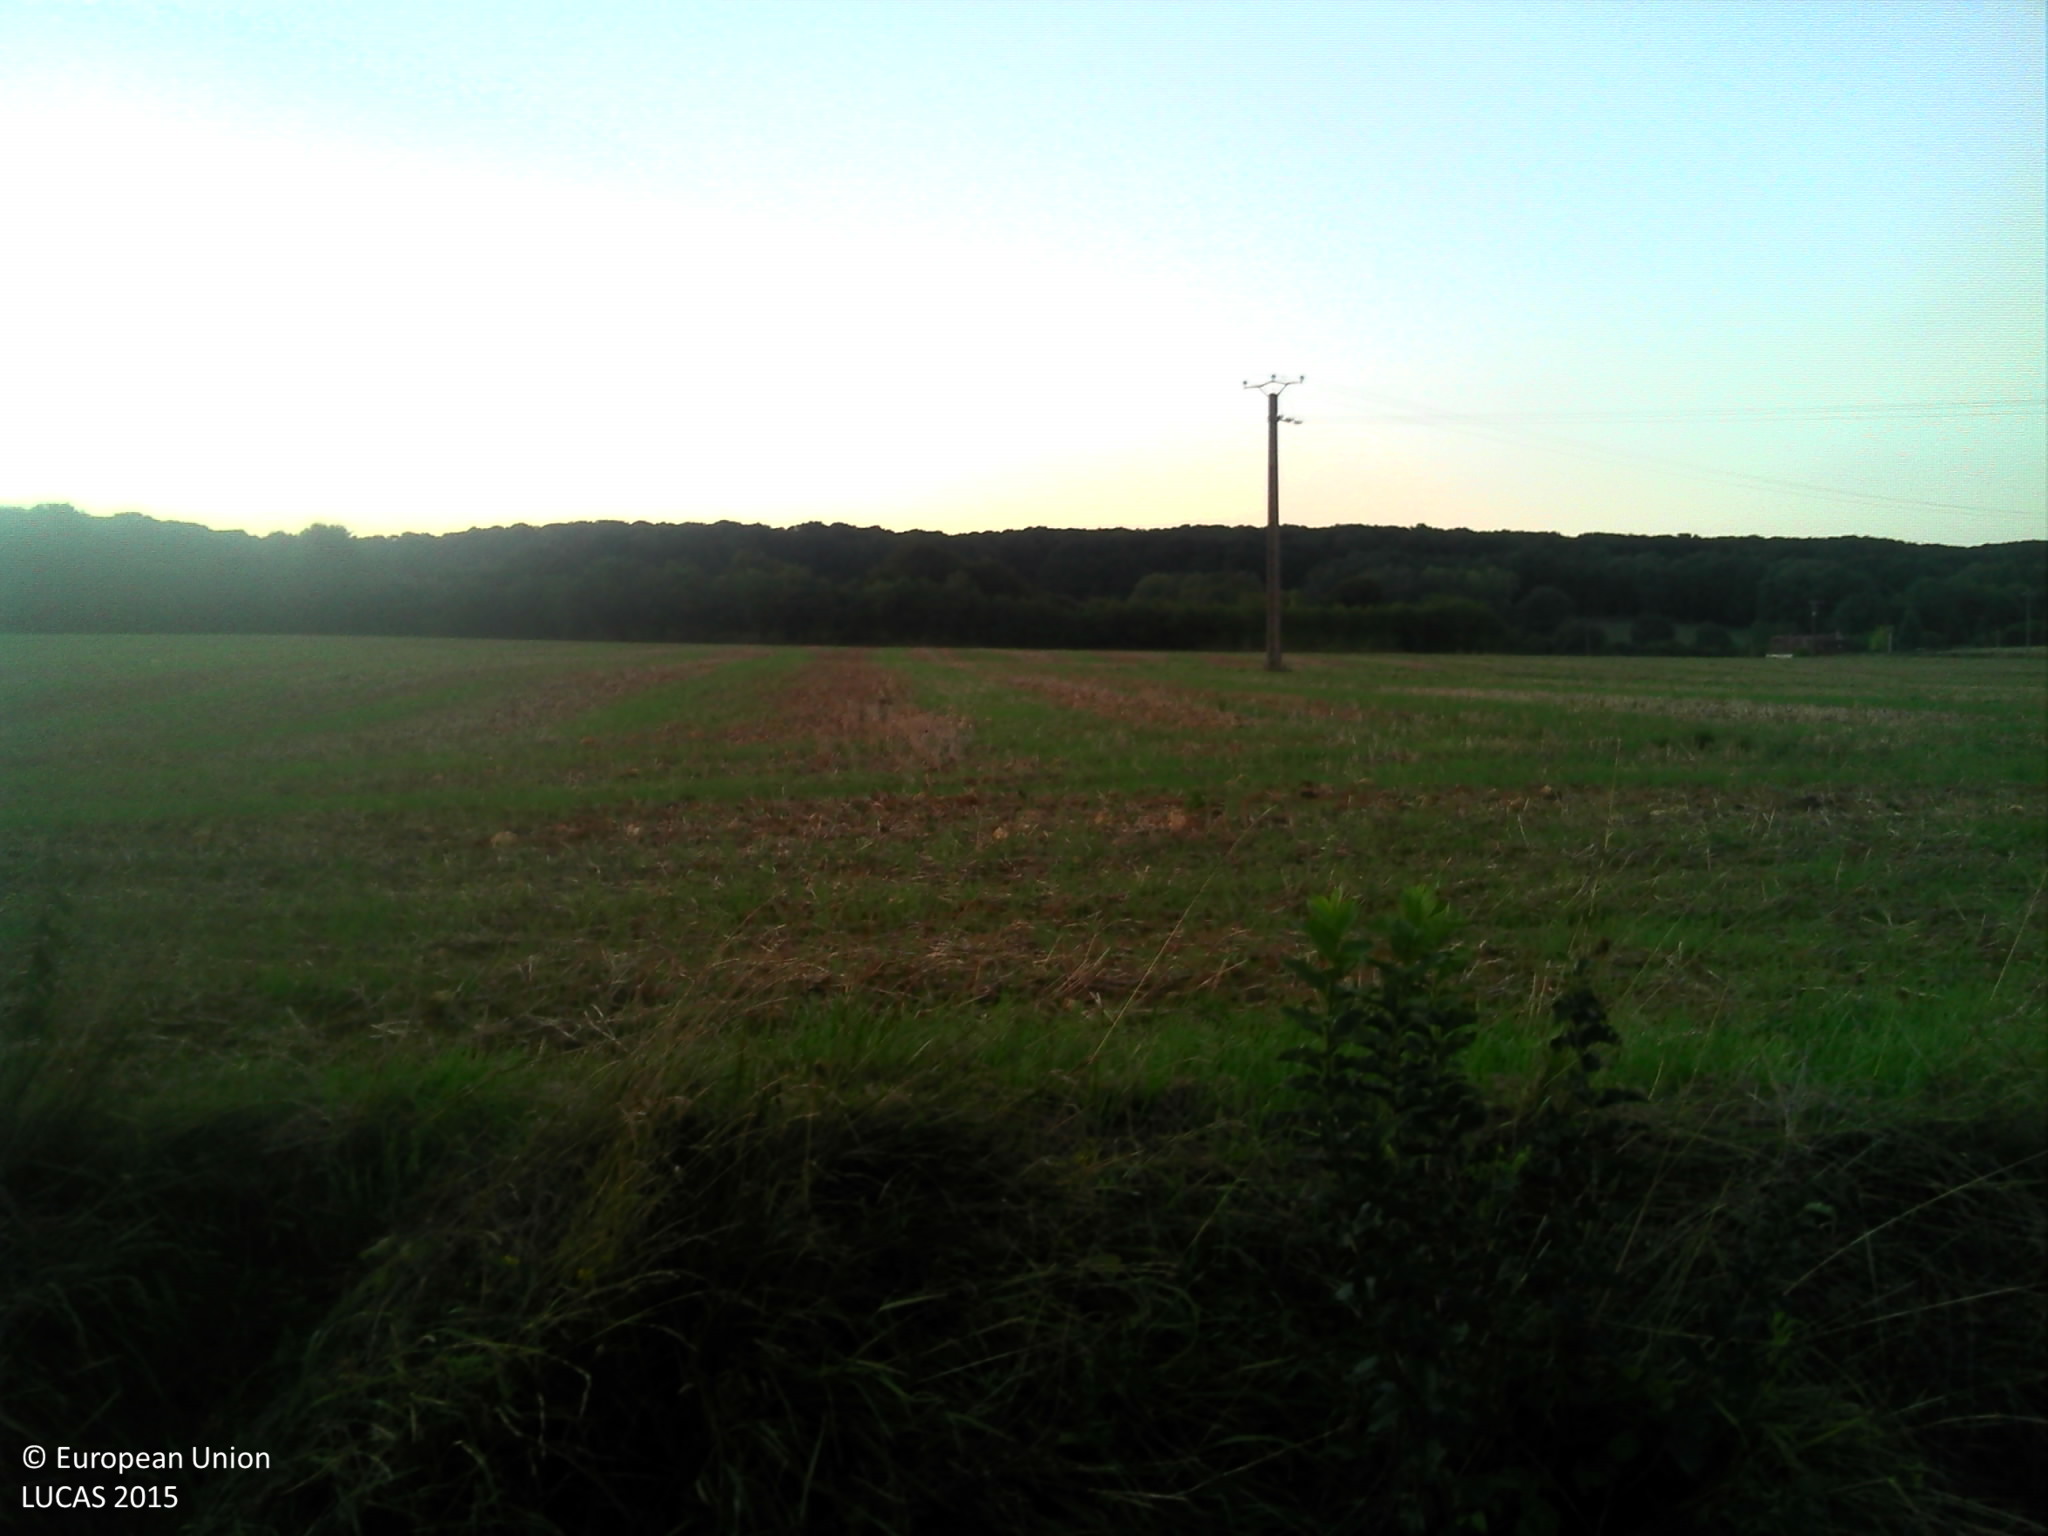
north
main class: Grassland
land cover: Grassland with sparse tree/shrub cover
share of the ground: > 75 %
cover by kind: herbaceous plants 95 %, broadleaved forest trees 5 %
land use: Residential
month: September
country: FR
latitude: 48.3751
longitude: 0.5117
